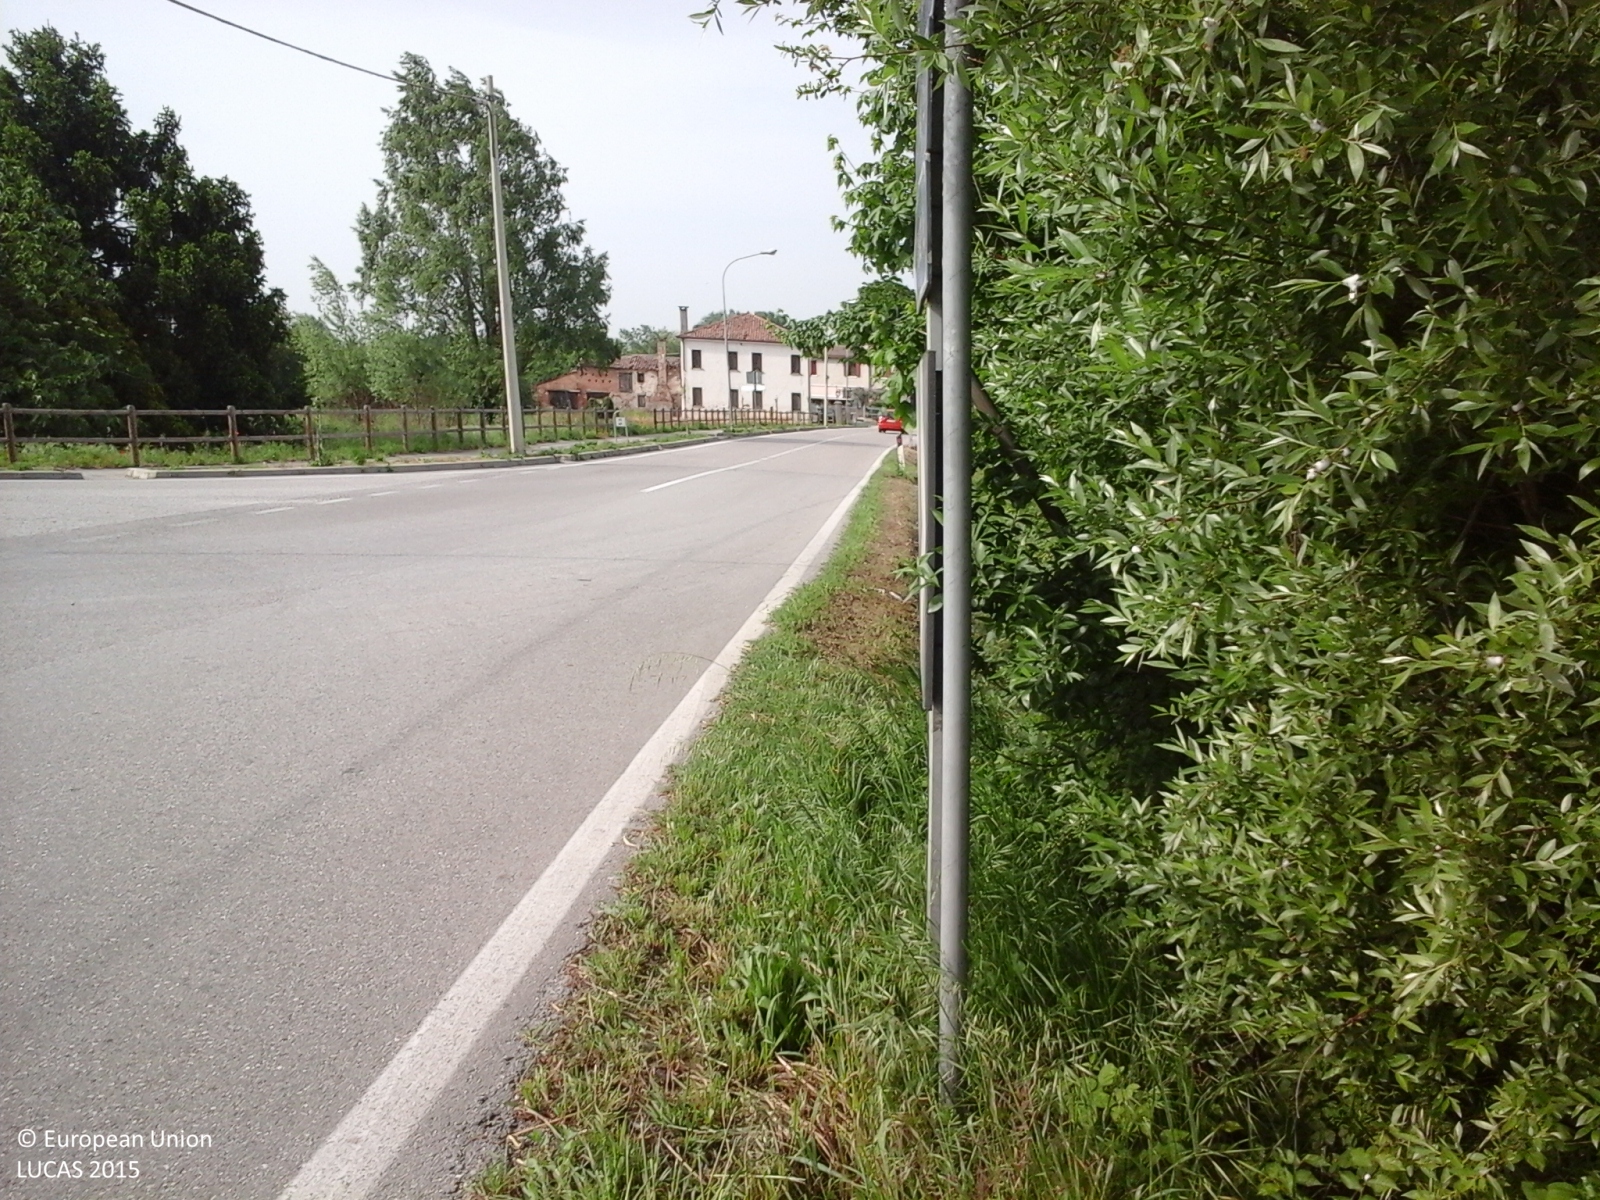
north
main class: Grassland
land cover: Grassland without tree/shrub cover
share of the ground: > 75 %
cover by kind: herbaceous plants 100 %
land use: Agriculture (excluding fallow land and kitchen gardens)
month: May
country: IT
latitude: 45.1480
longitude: 11.7139
